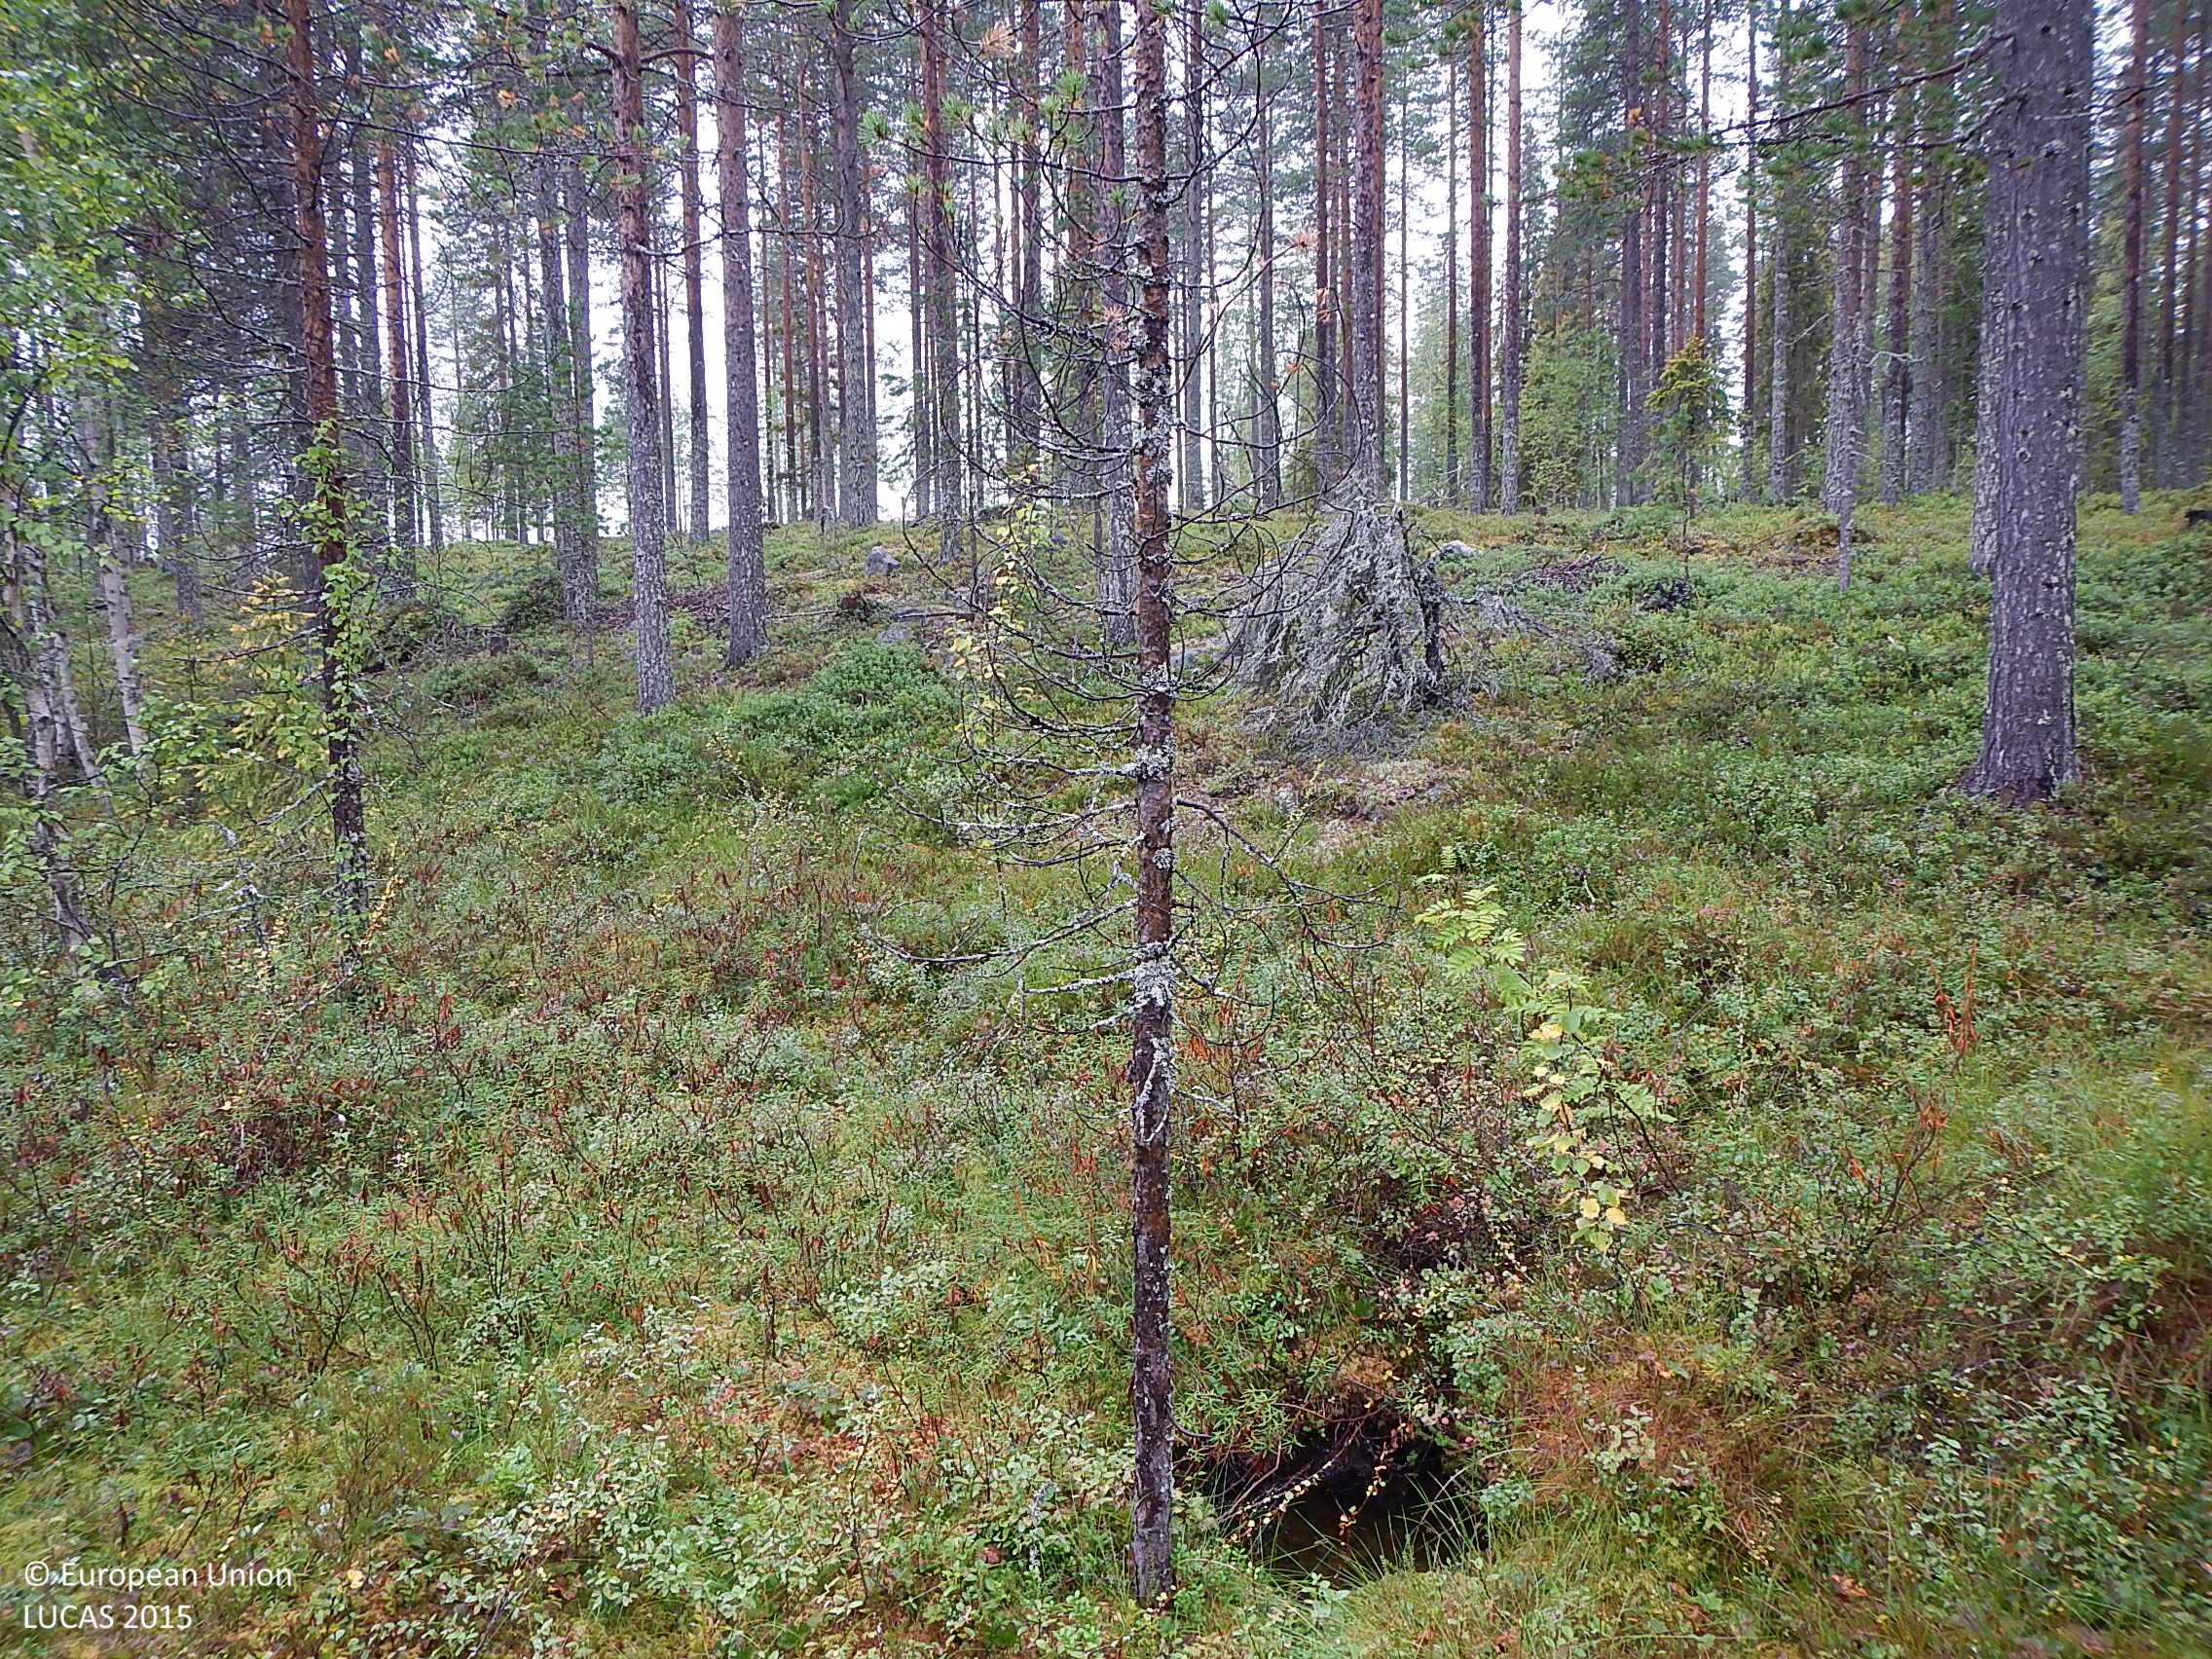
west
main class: Woodland
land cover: Pine dominated coniferous woodland
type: boreal forest
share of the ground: 50 - 75 %
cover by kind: coniferous forest trees 60 %, shrubs 20 %, broadleaved forest trees 10 %, herbaceous plants 10 %
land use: Forestry
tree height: > 5 m
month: August
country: FI
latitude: 65.9762
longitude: 27.3994
